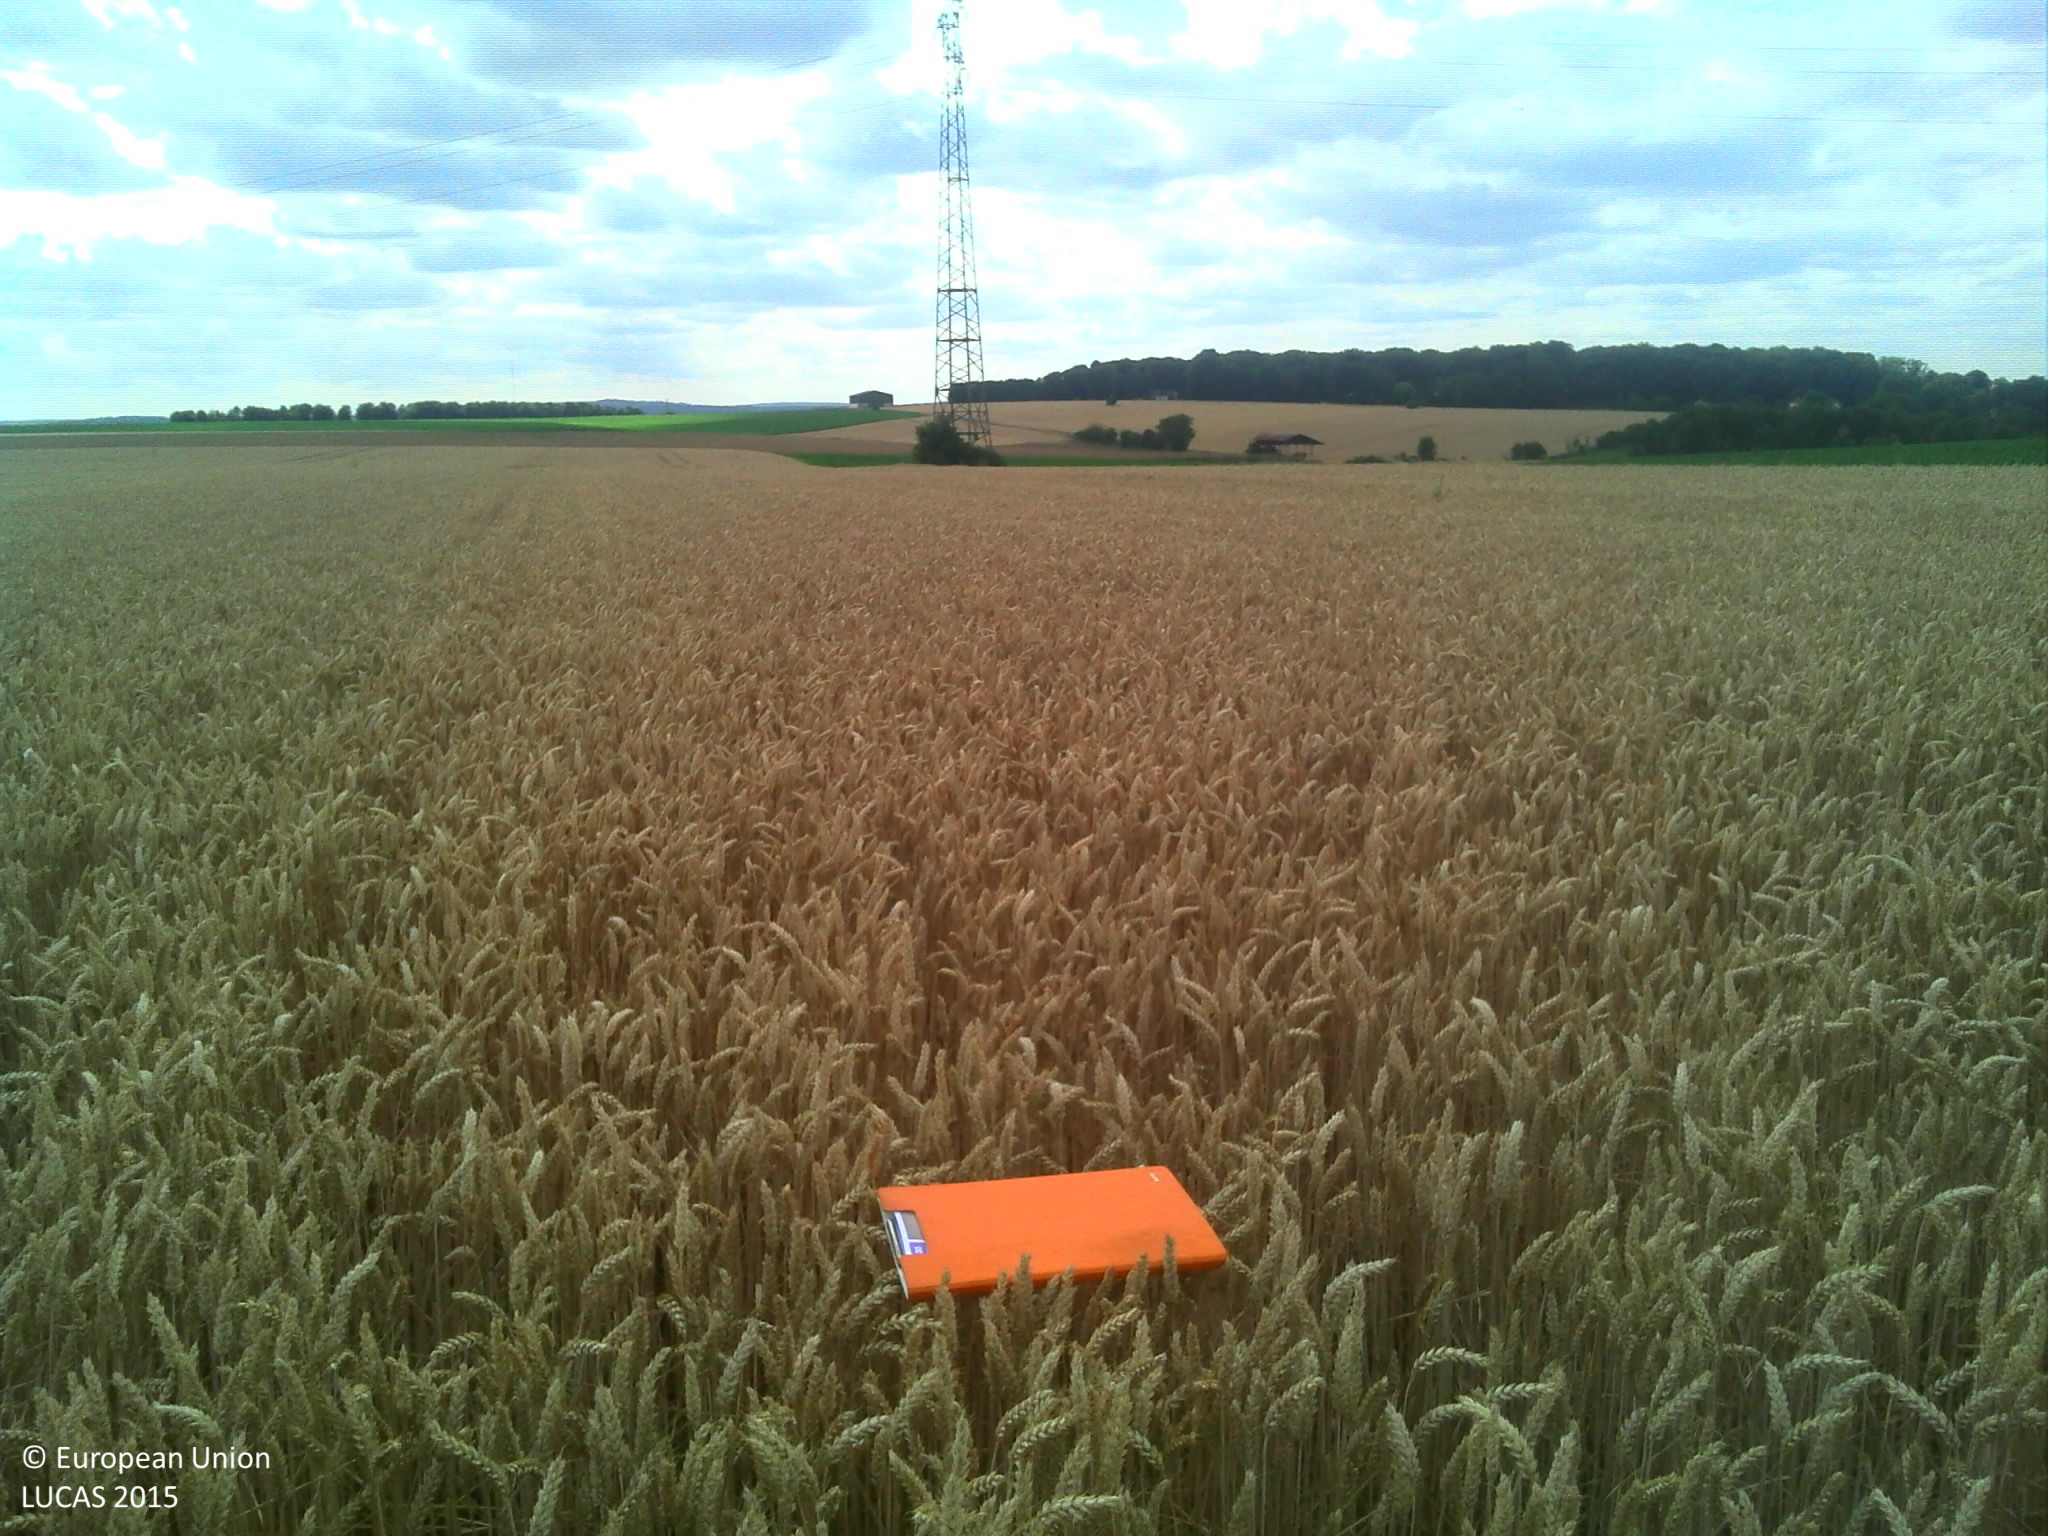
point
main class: Cropland
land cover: Common wheat
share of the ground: > 75 %
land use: Agriculture (excluding fallow land and kitchen gardens)
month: July
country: FR
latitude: 49.2831
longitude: 3.2973
